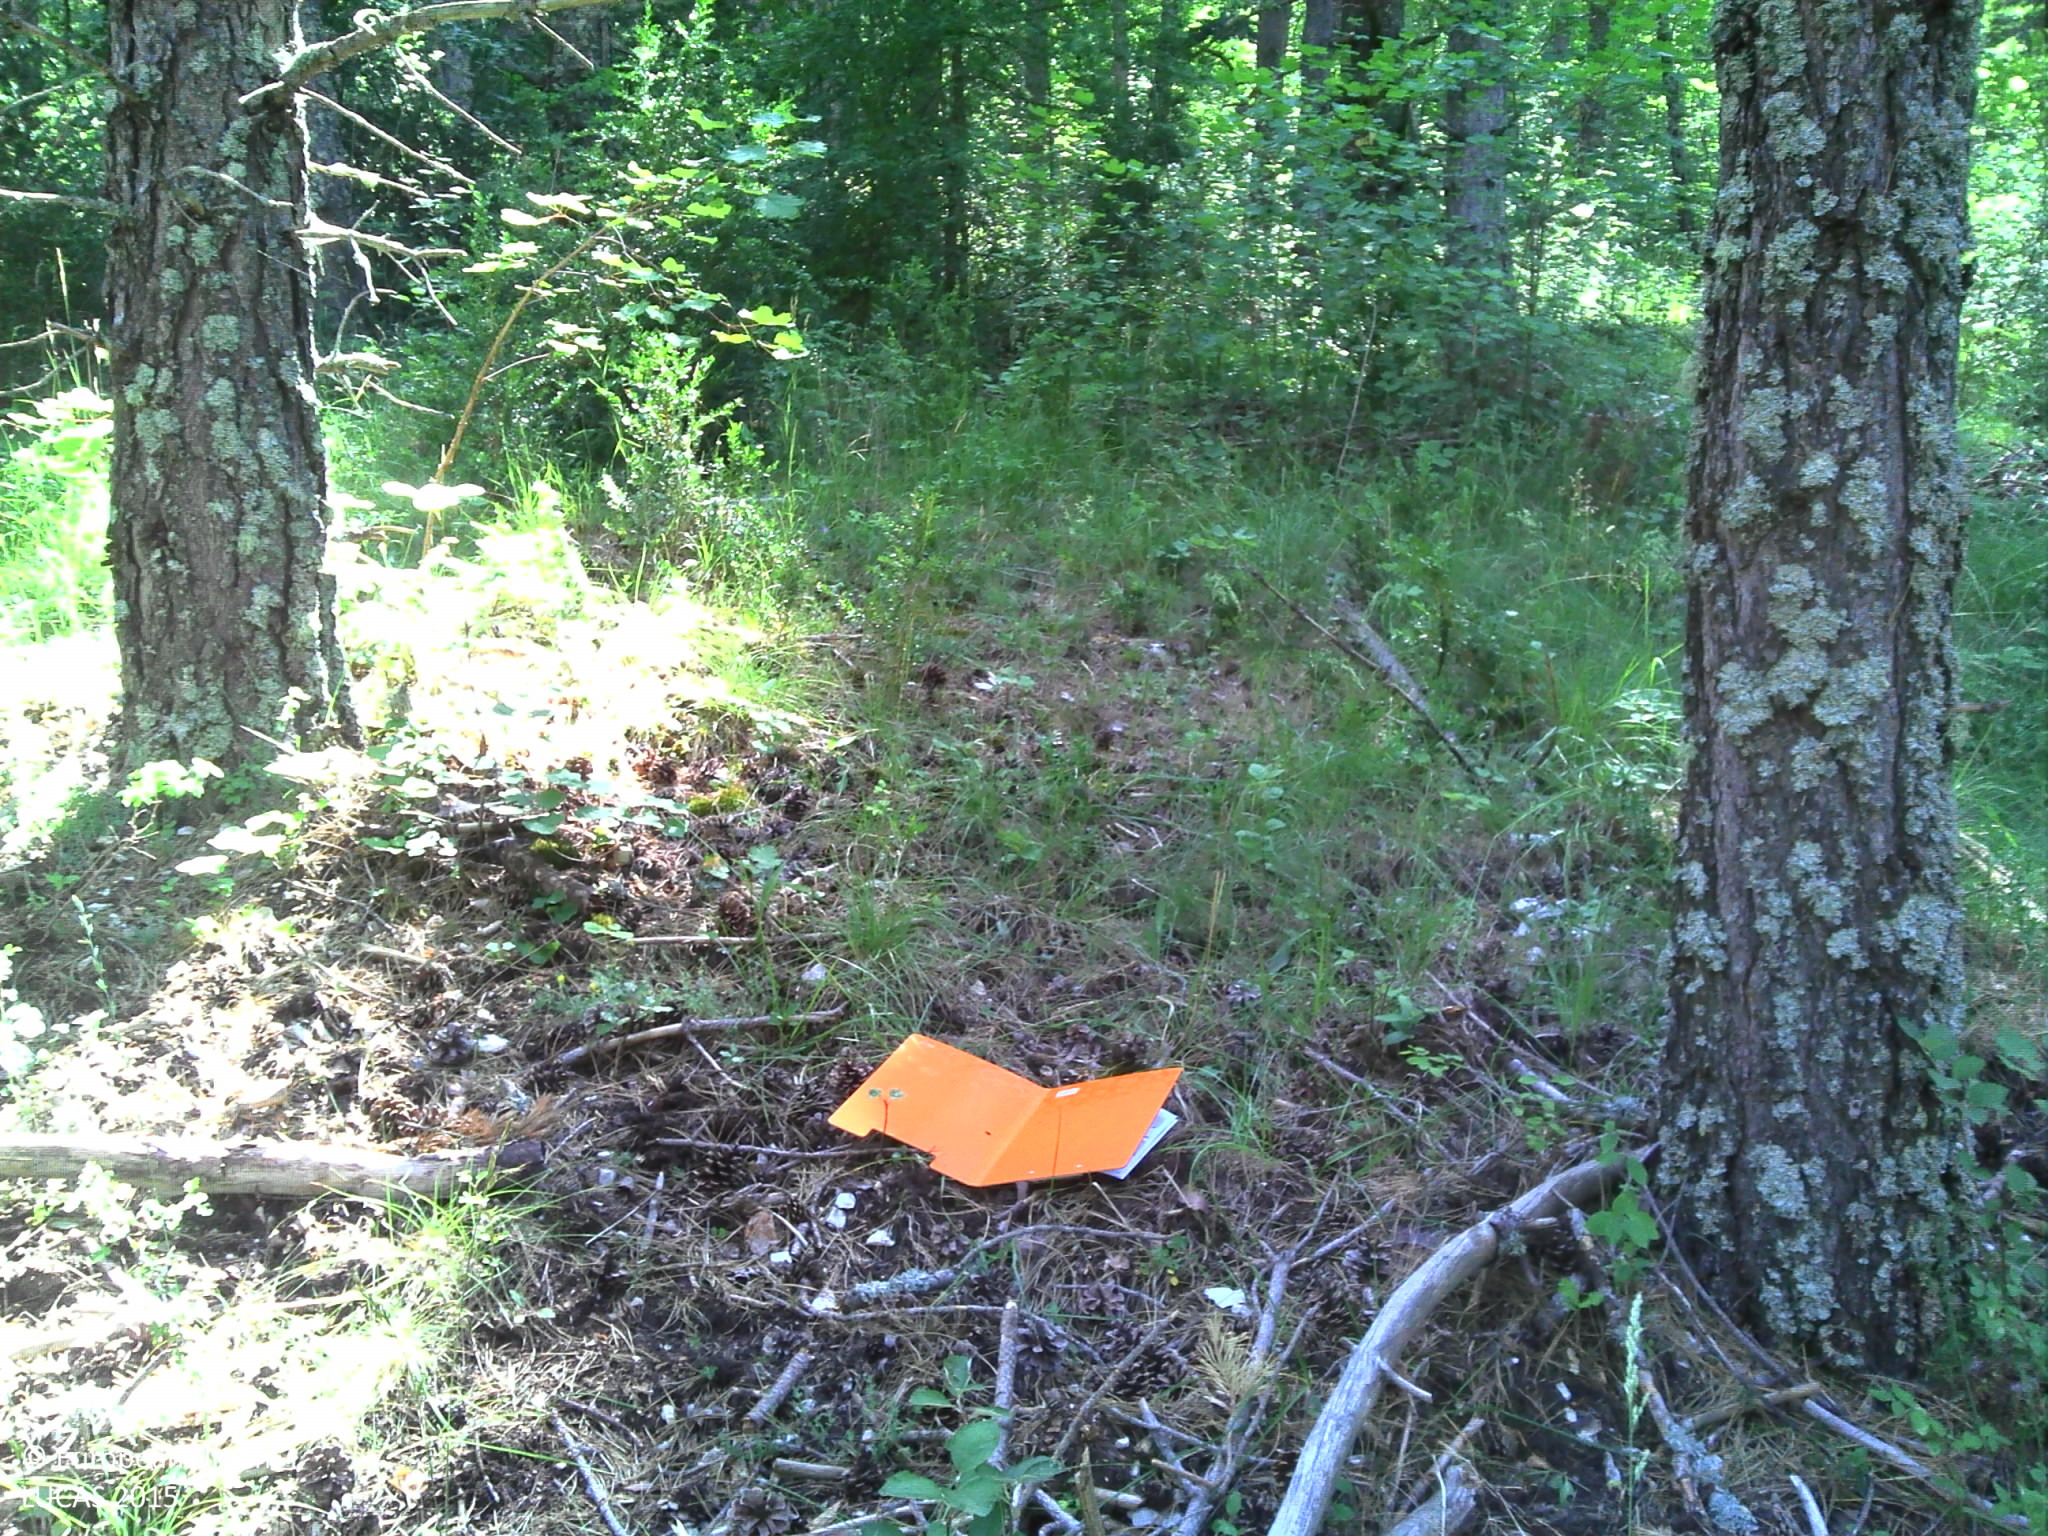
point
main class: Woodland
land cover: Pine dominated coniferous woodland
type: coniferous forest of the mediterranean region
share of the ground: > 75 %
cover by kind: coniferous forest trees 80 %, shrubs 10 %, herbaceous plants 10 %
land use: Forestry
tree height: > 5 m
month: July
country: FR
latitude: 43.8689
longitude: 6.2874
